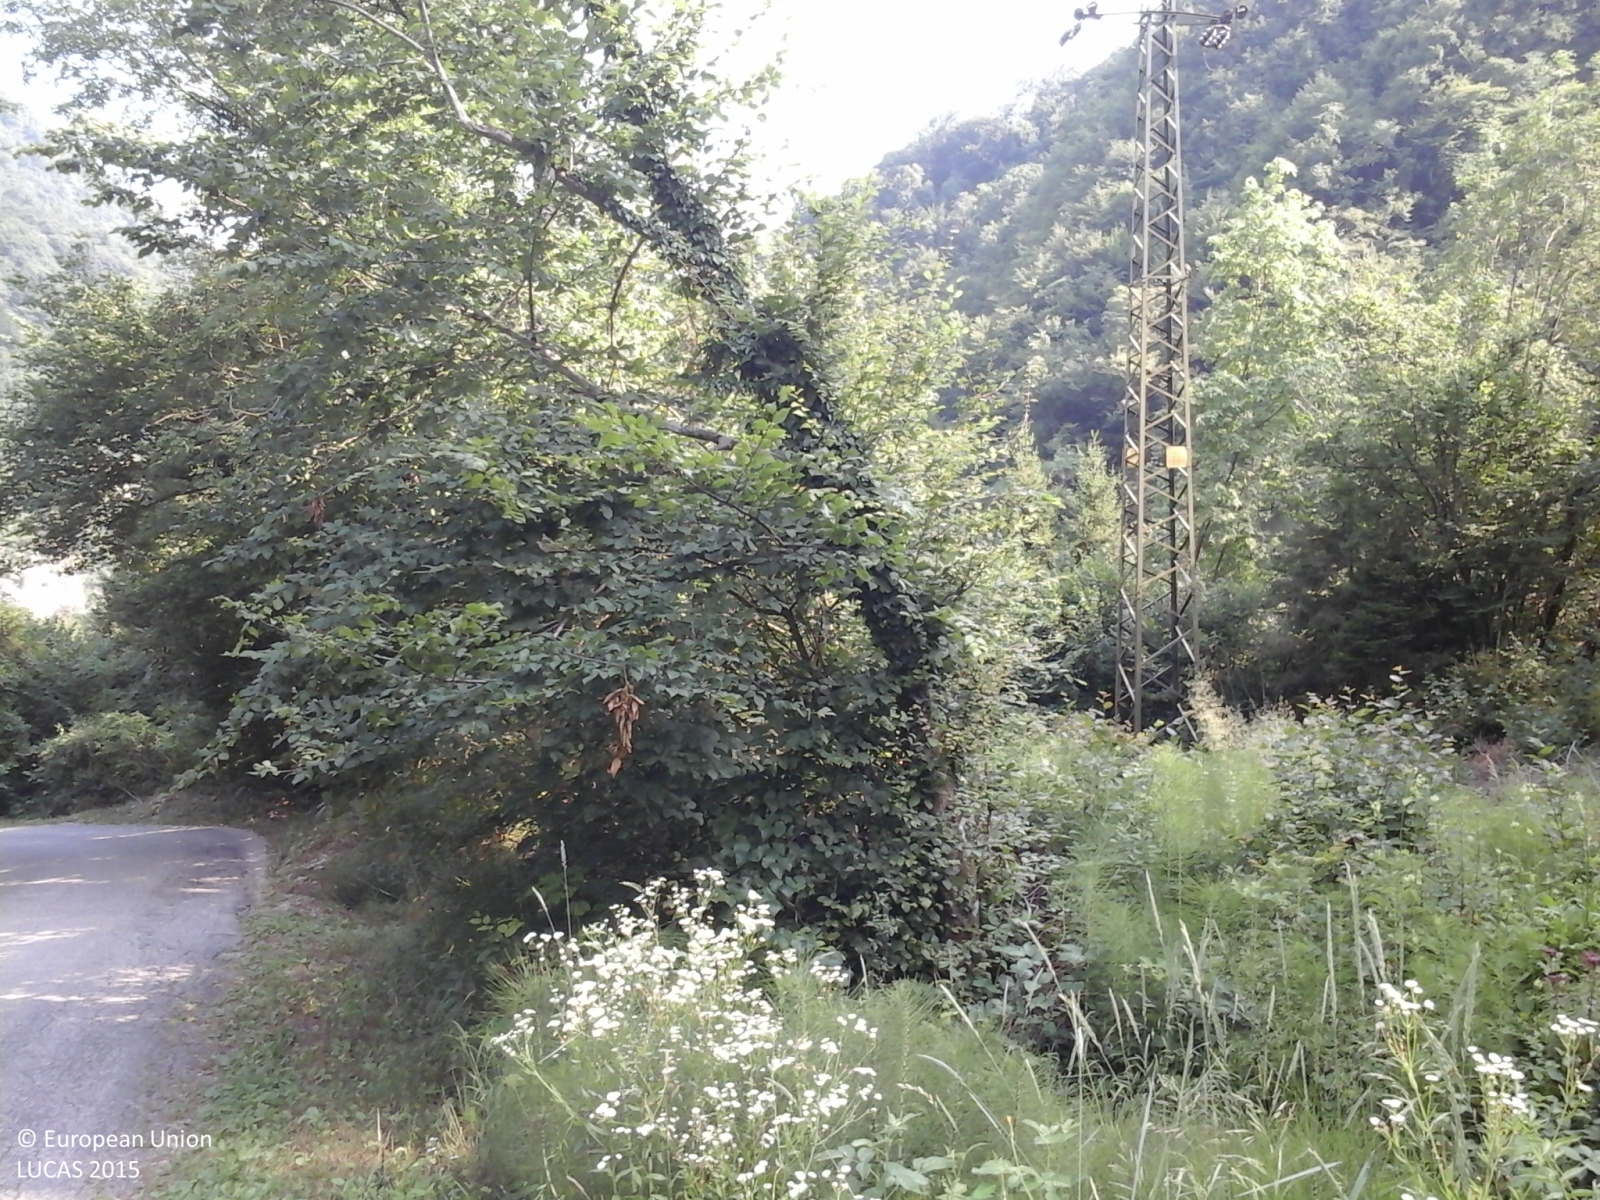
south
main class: Woodland
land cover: Broadleaved woodland
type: thermophilous deciduous forest
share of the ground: > 75 %
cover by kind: broadleaved forest trees 100 %
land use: Semi-natural and natural areas not in use
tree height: > 5 m
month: July
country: IT
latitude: 46.0992
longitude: 11.9507
